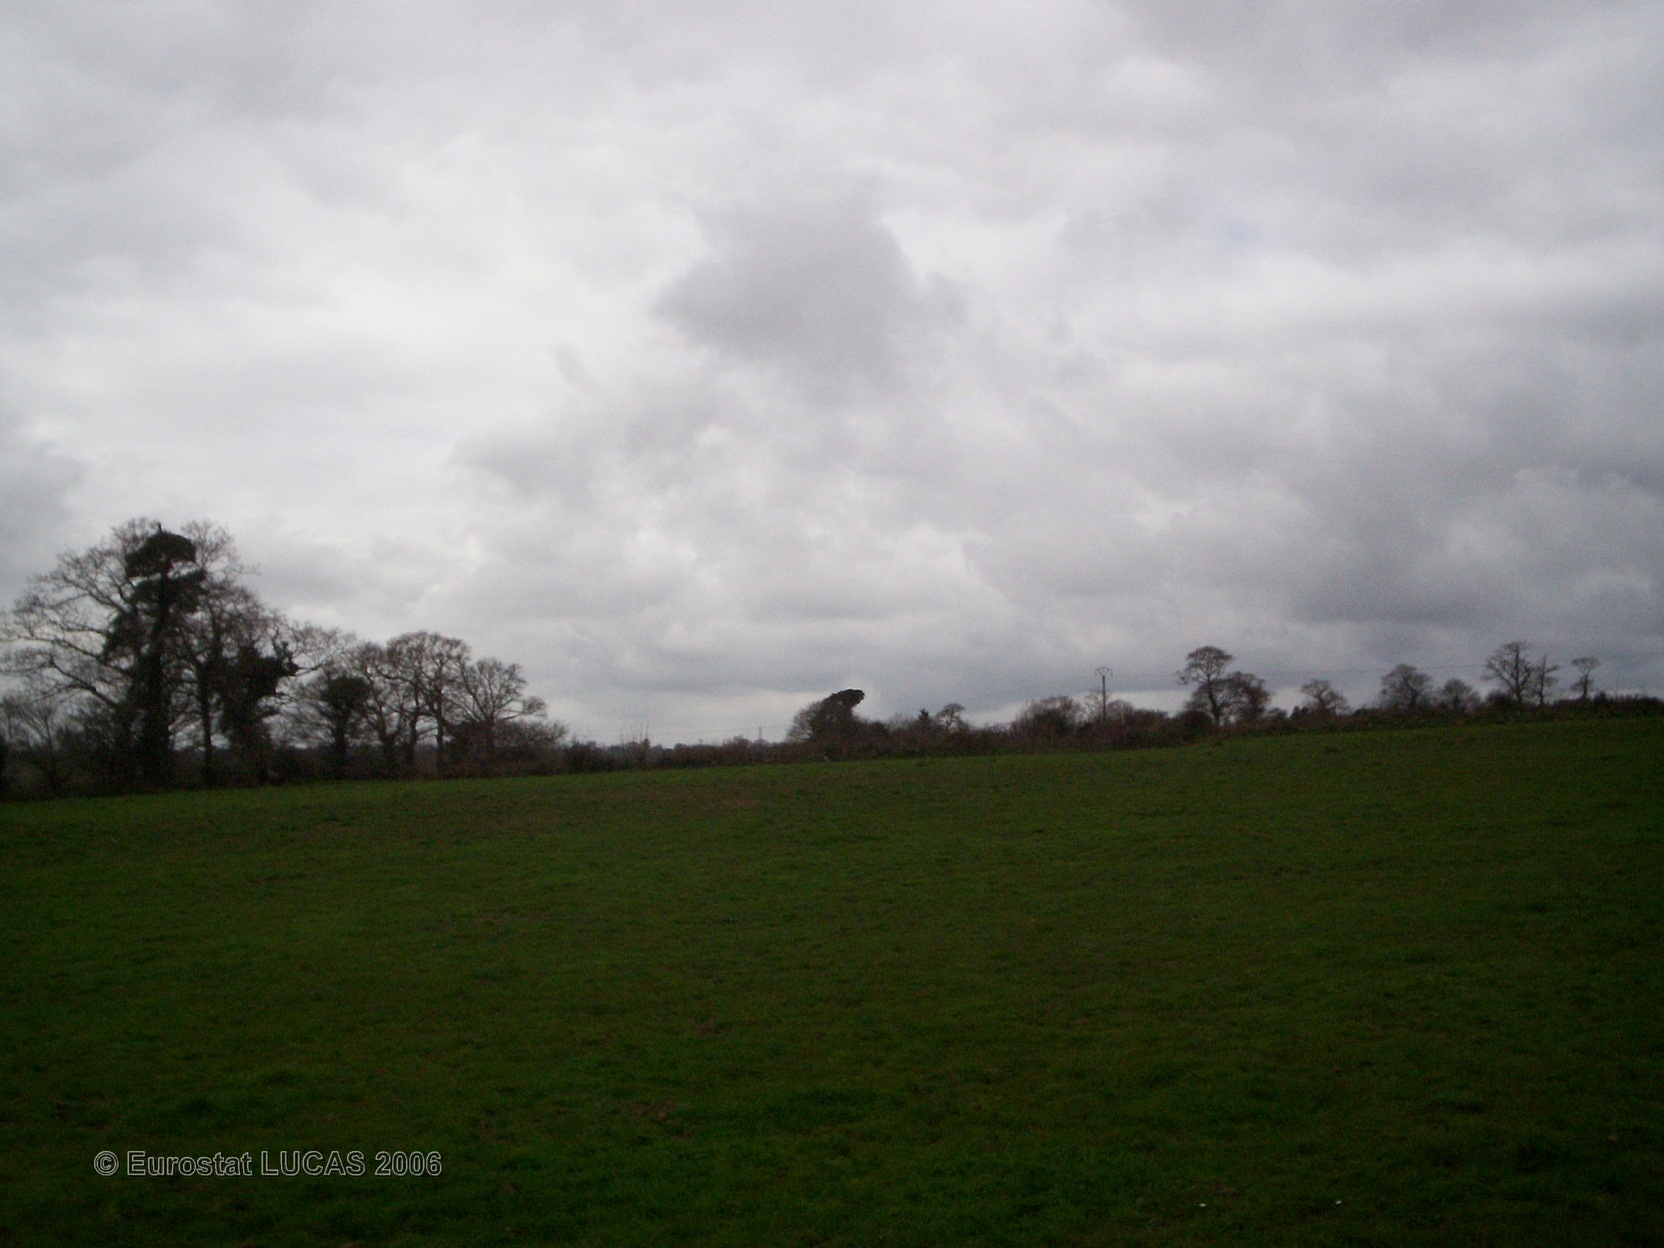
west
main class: Grassland
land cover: Grassland without tree/shrub cover
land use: Agriculture (excluding fallow land and kitchen gardens)
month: April
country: FR
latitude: 49.5356
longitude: -1.4207
